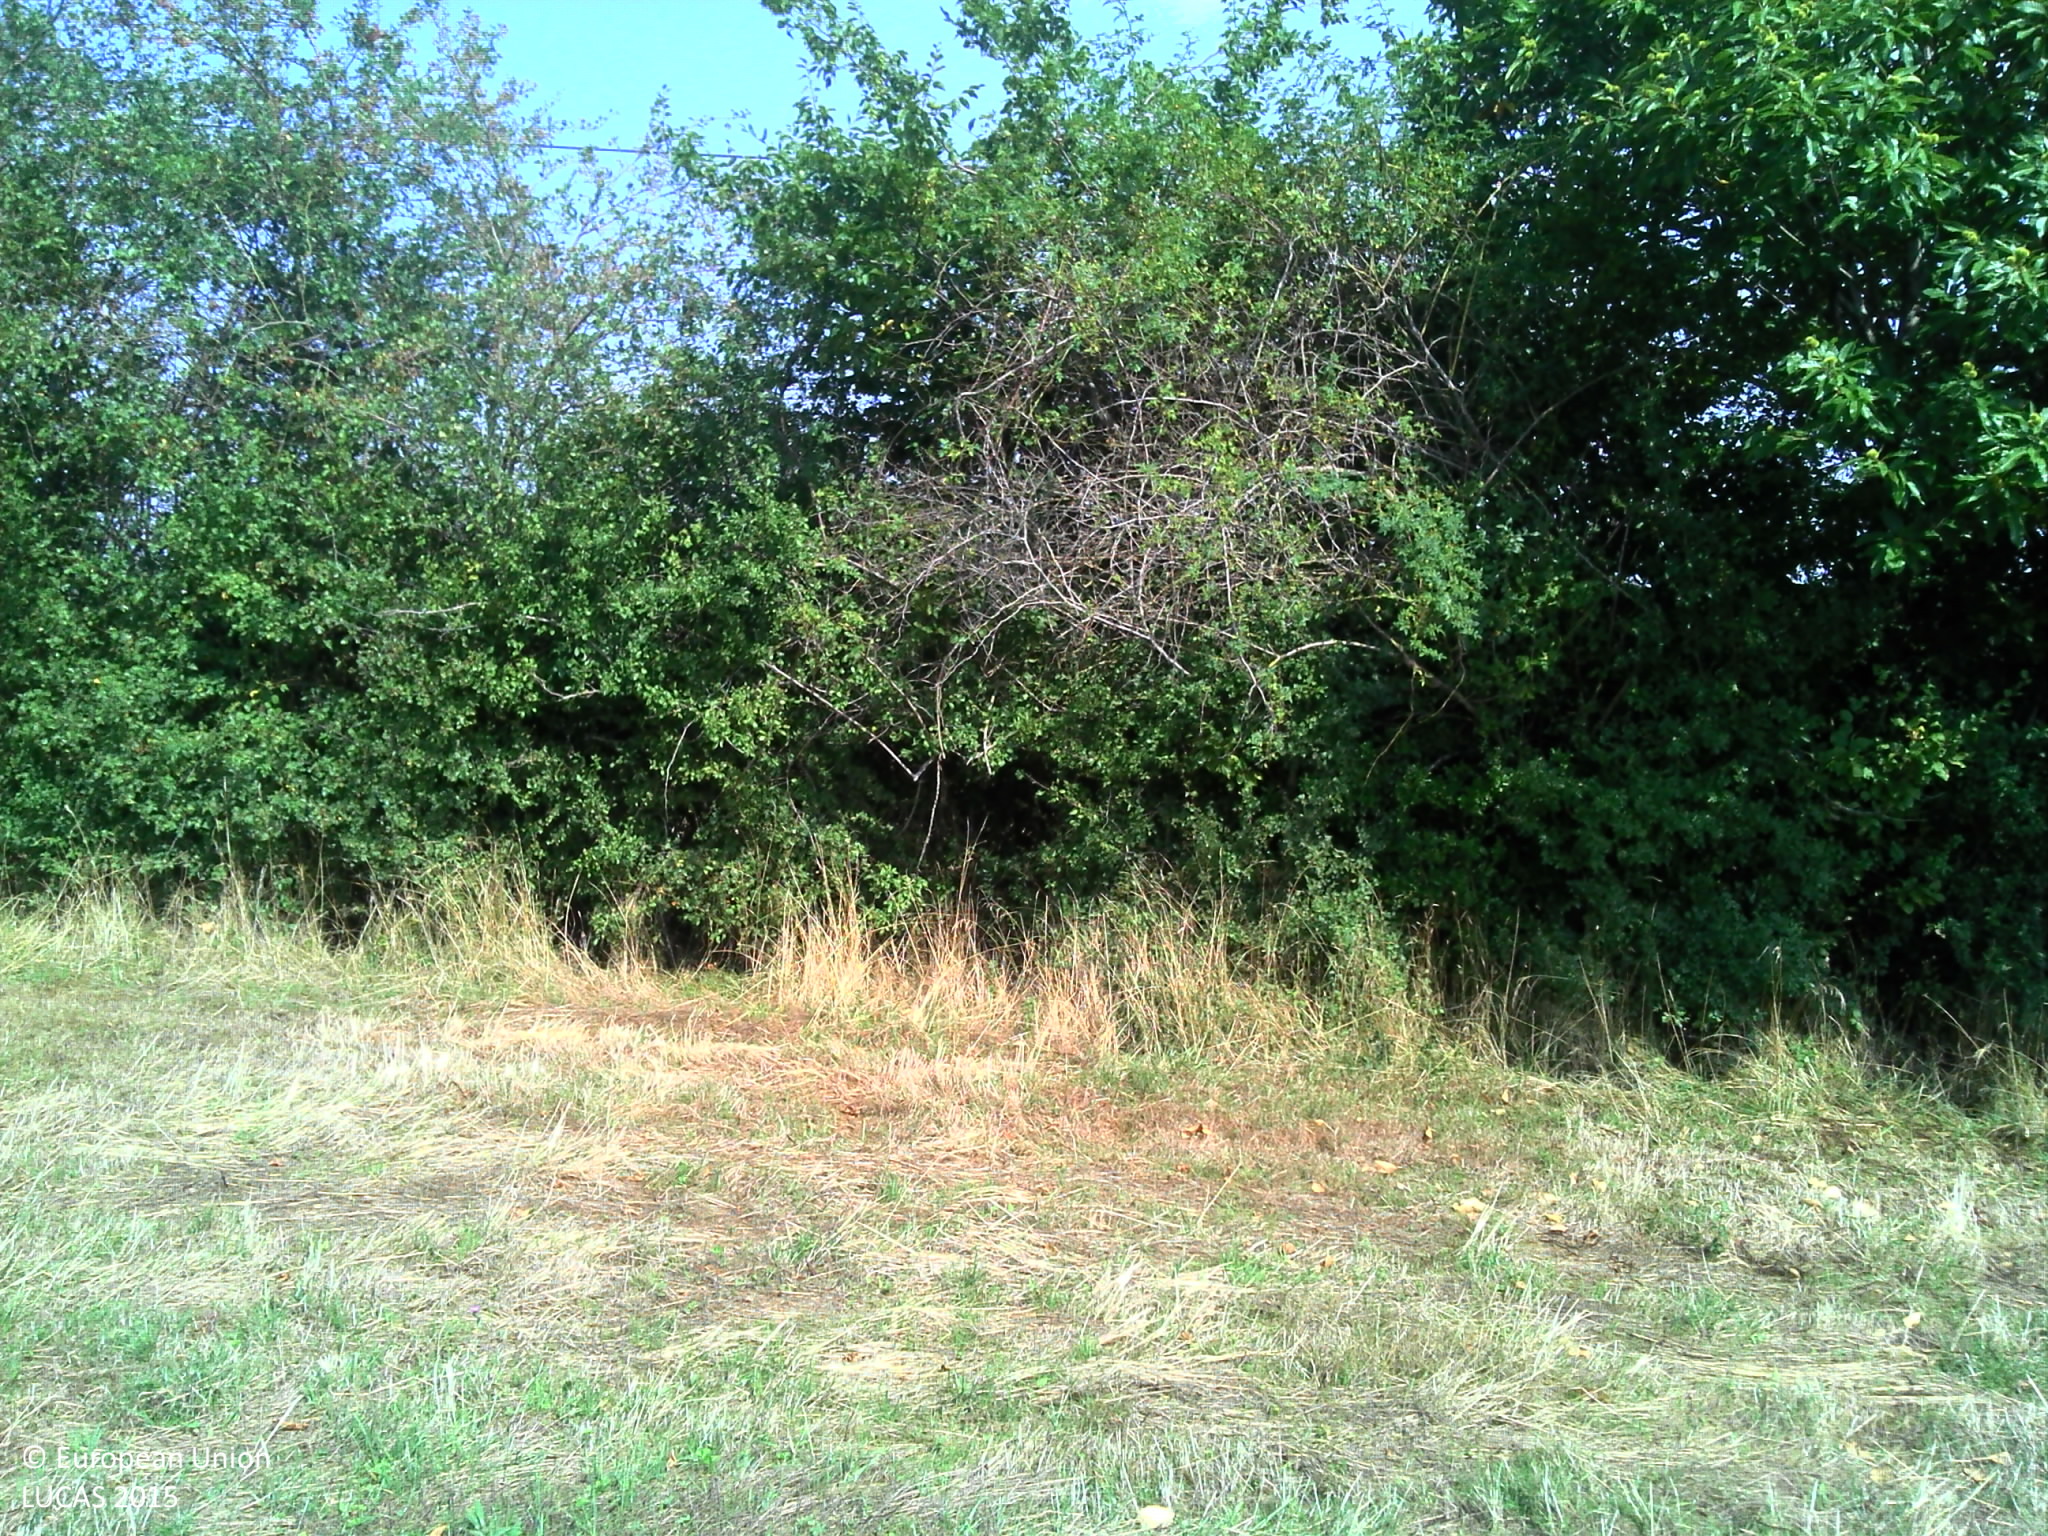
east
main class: Grassland
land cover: Grassland without tree/shrub cover
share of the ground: > 75 %
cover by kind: herbaceous plants 100 %
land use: Agriculture (excluding fallow land and kitchen gardens)
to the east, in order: Grassland without tree/shrub cover; Fences; Abandoned hedges; Electric lines; Ditches and canals; Grass margins; Paved roads, cycling and walking lanes; Grass margins; Fences; Grassland without tree/shrub cover; Fences; Managed hedges; Grassland without tree/shrub cover; Fences; Managed hedges; Grassland without tree/shrub cover; Rivers and streams; Grassland without tree/shrub cover
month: August
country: FR
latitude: 46.3803
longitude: 3.6678
